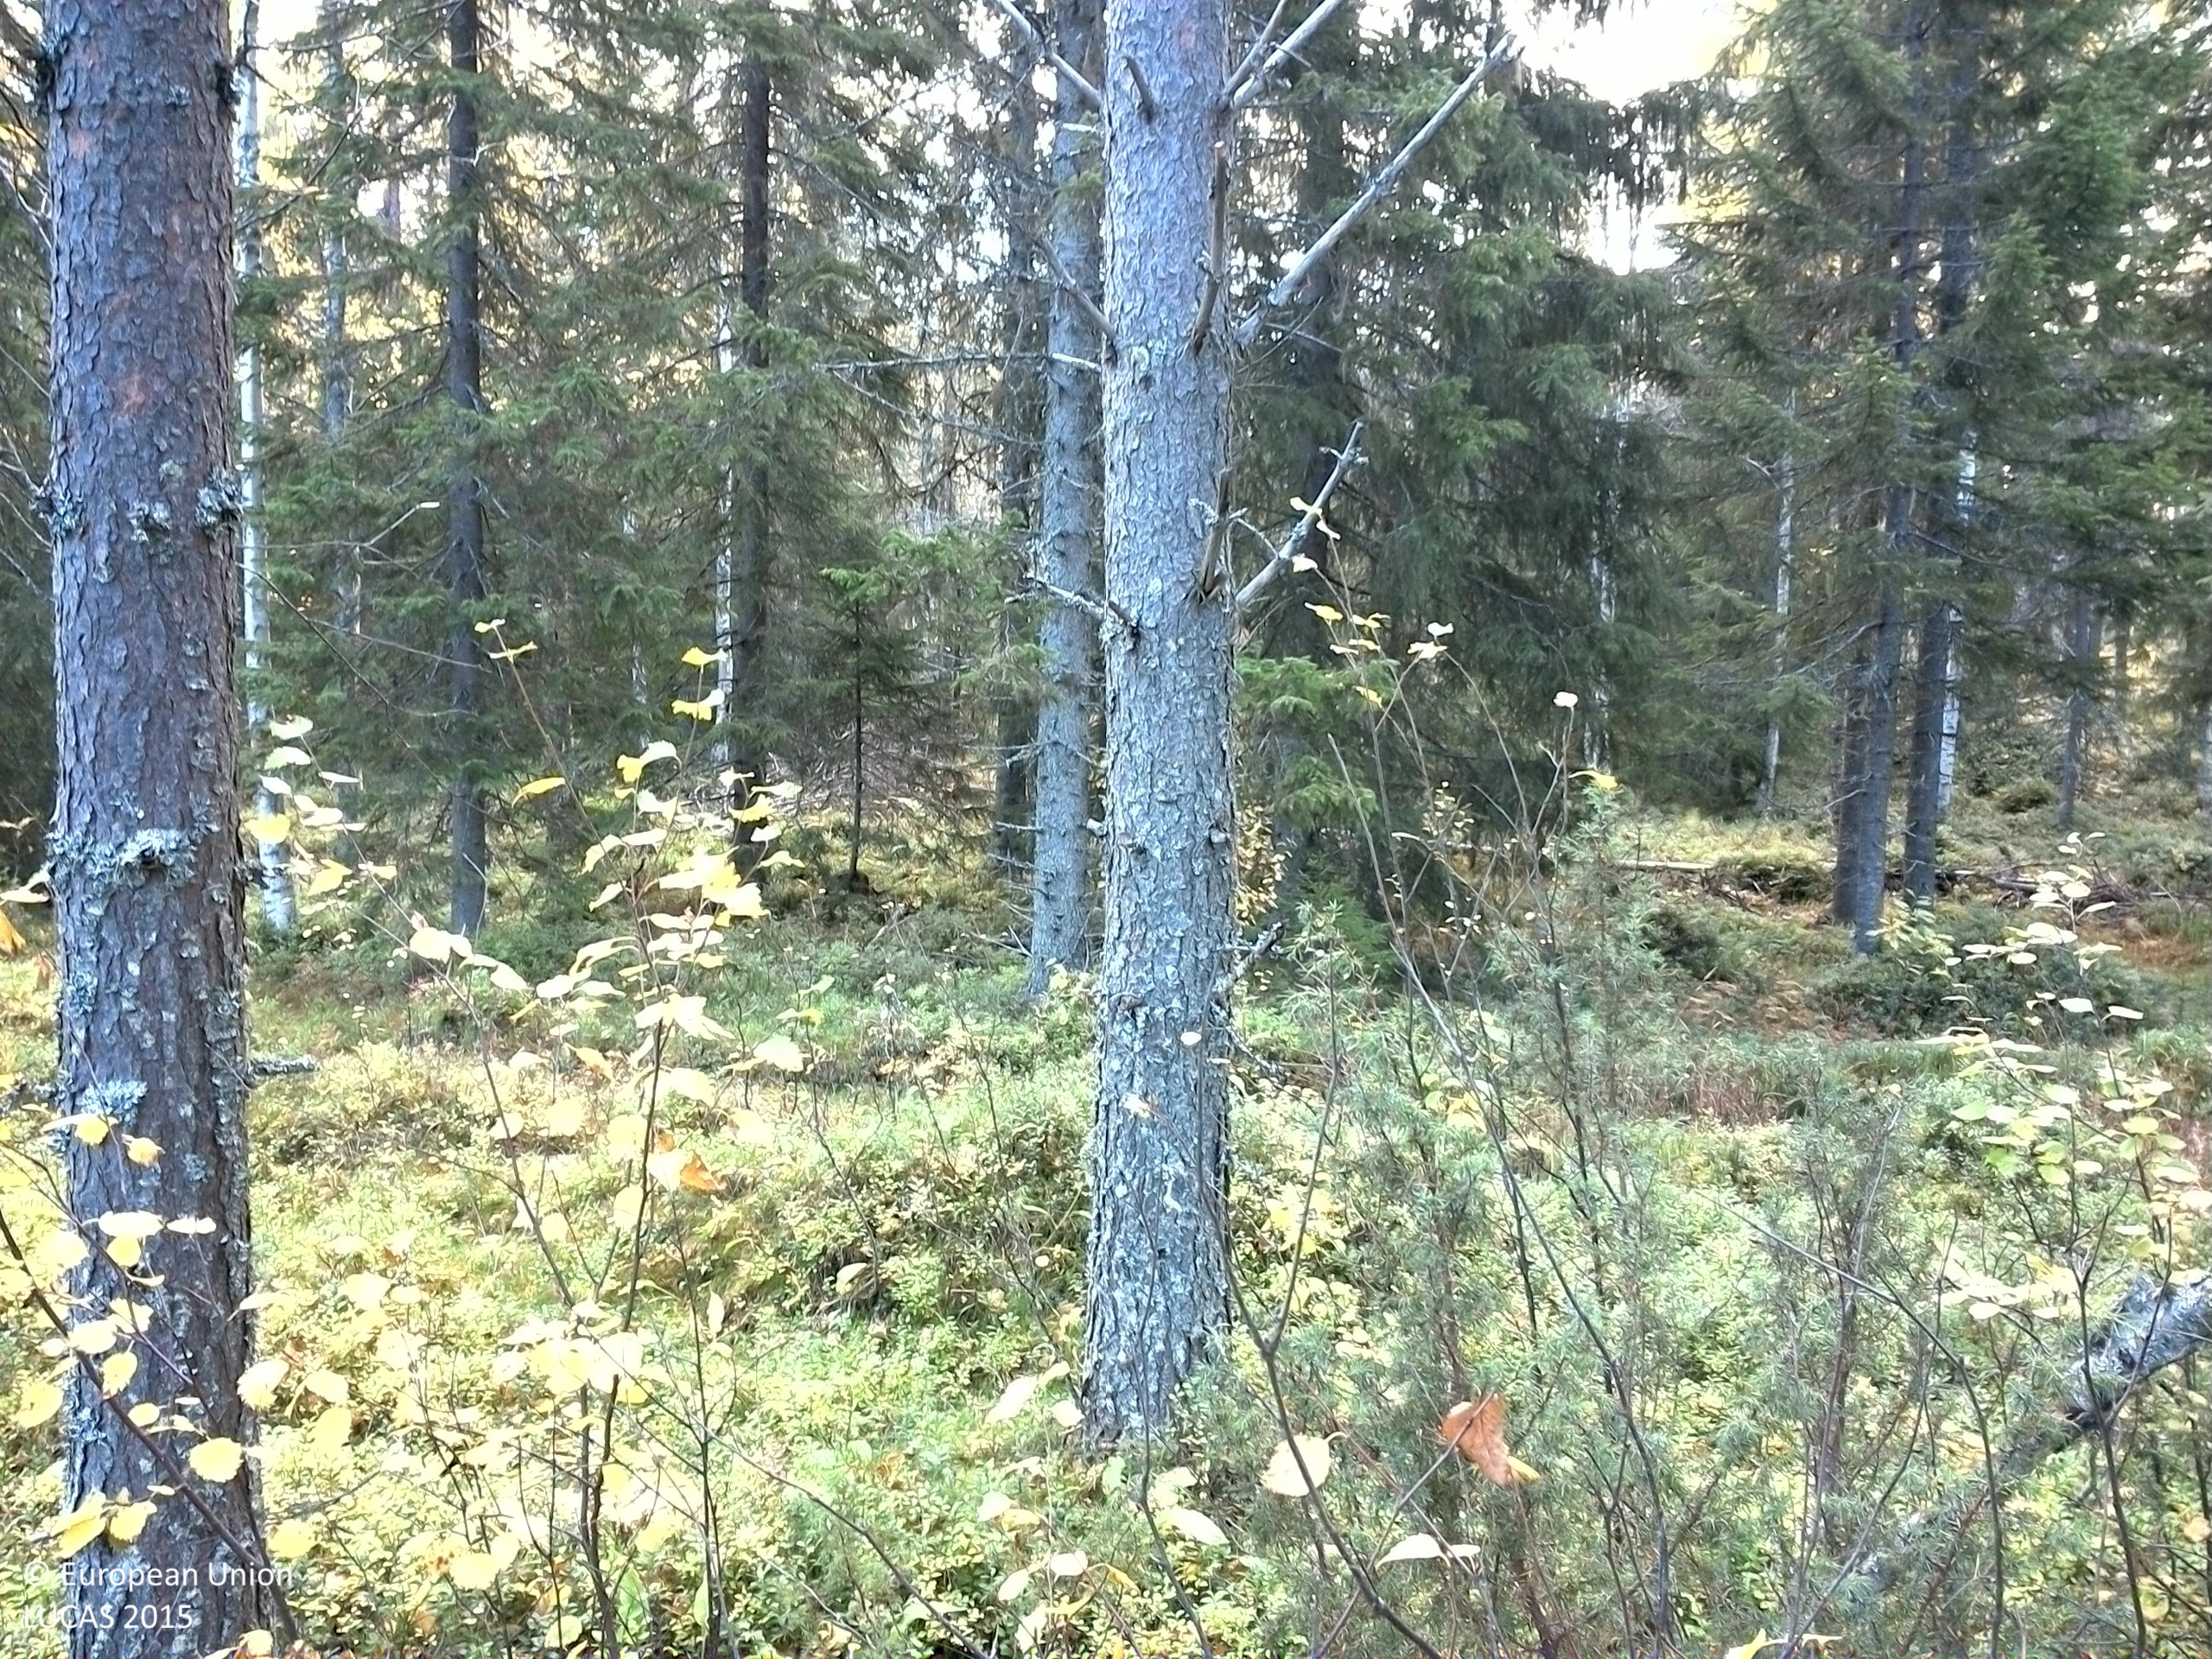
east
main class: Woodland
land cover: Other mixed woodland
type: boreal forest
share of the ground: 50 - 75 %
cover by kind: coniferous forest trees 35 %, shrubs 30 %, broadleaved forest trees 20 %, lichens and mosses 10 %, herbaceous plants 5 %
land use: Forestry
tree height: > 5 m
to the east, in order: Other mixed woodland; Rivers and streams; Other mixed woodland; Pine dominated mixed woodland; Pine dominated coniferous woodland
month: September
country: SE
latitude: 64.2172
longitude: 16.3370
